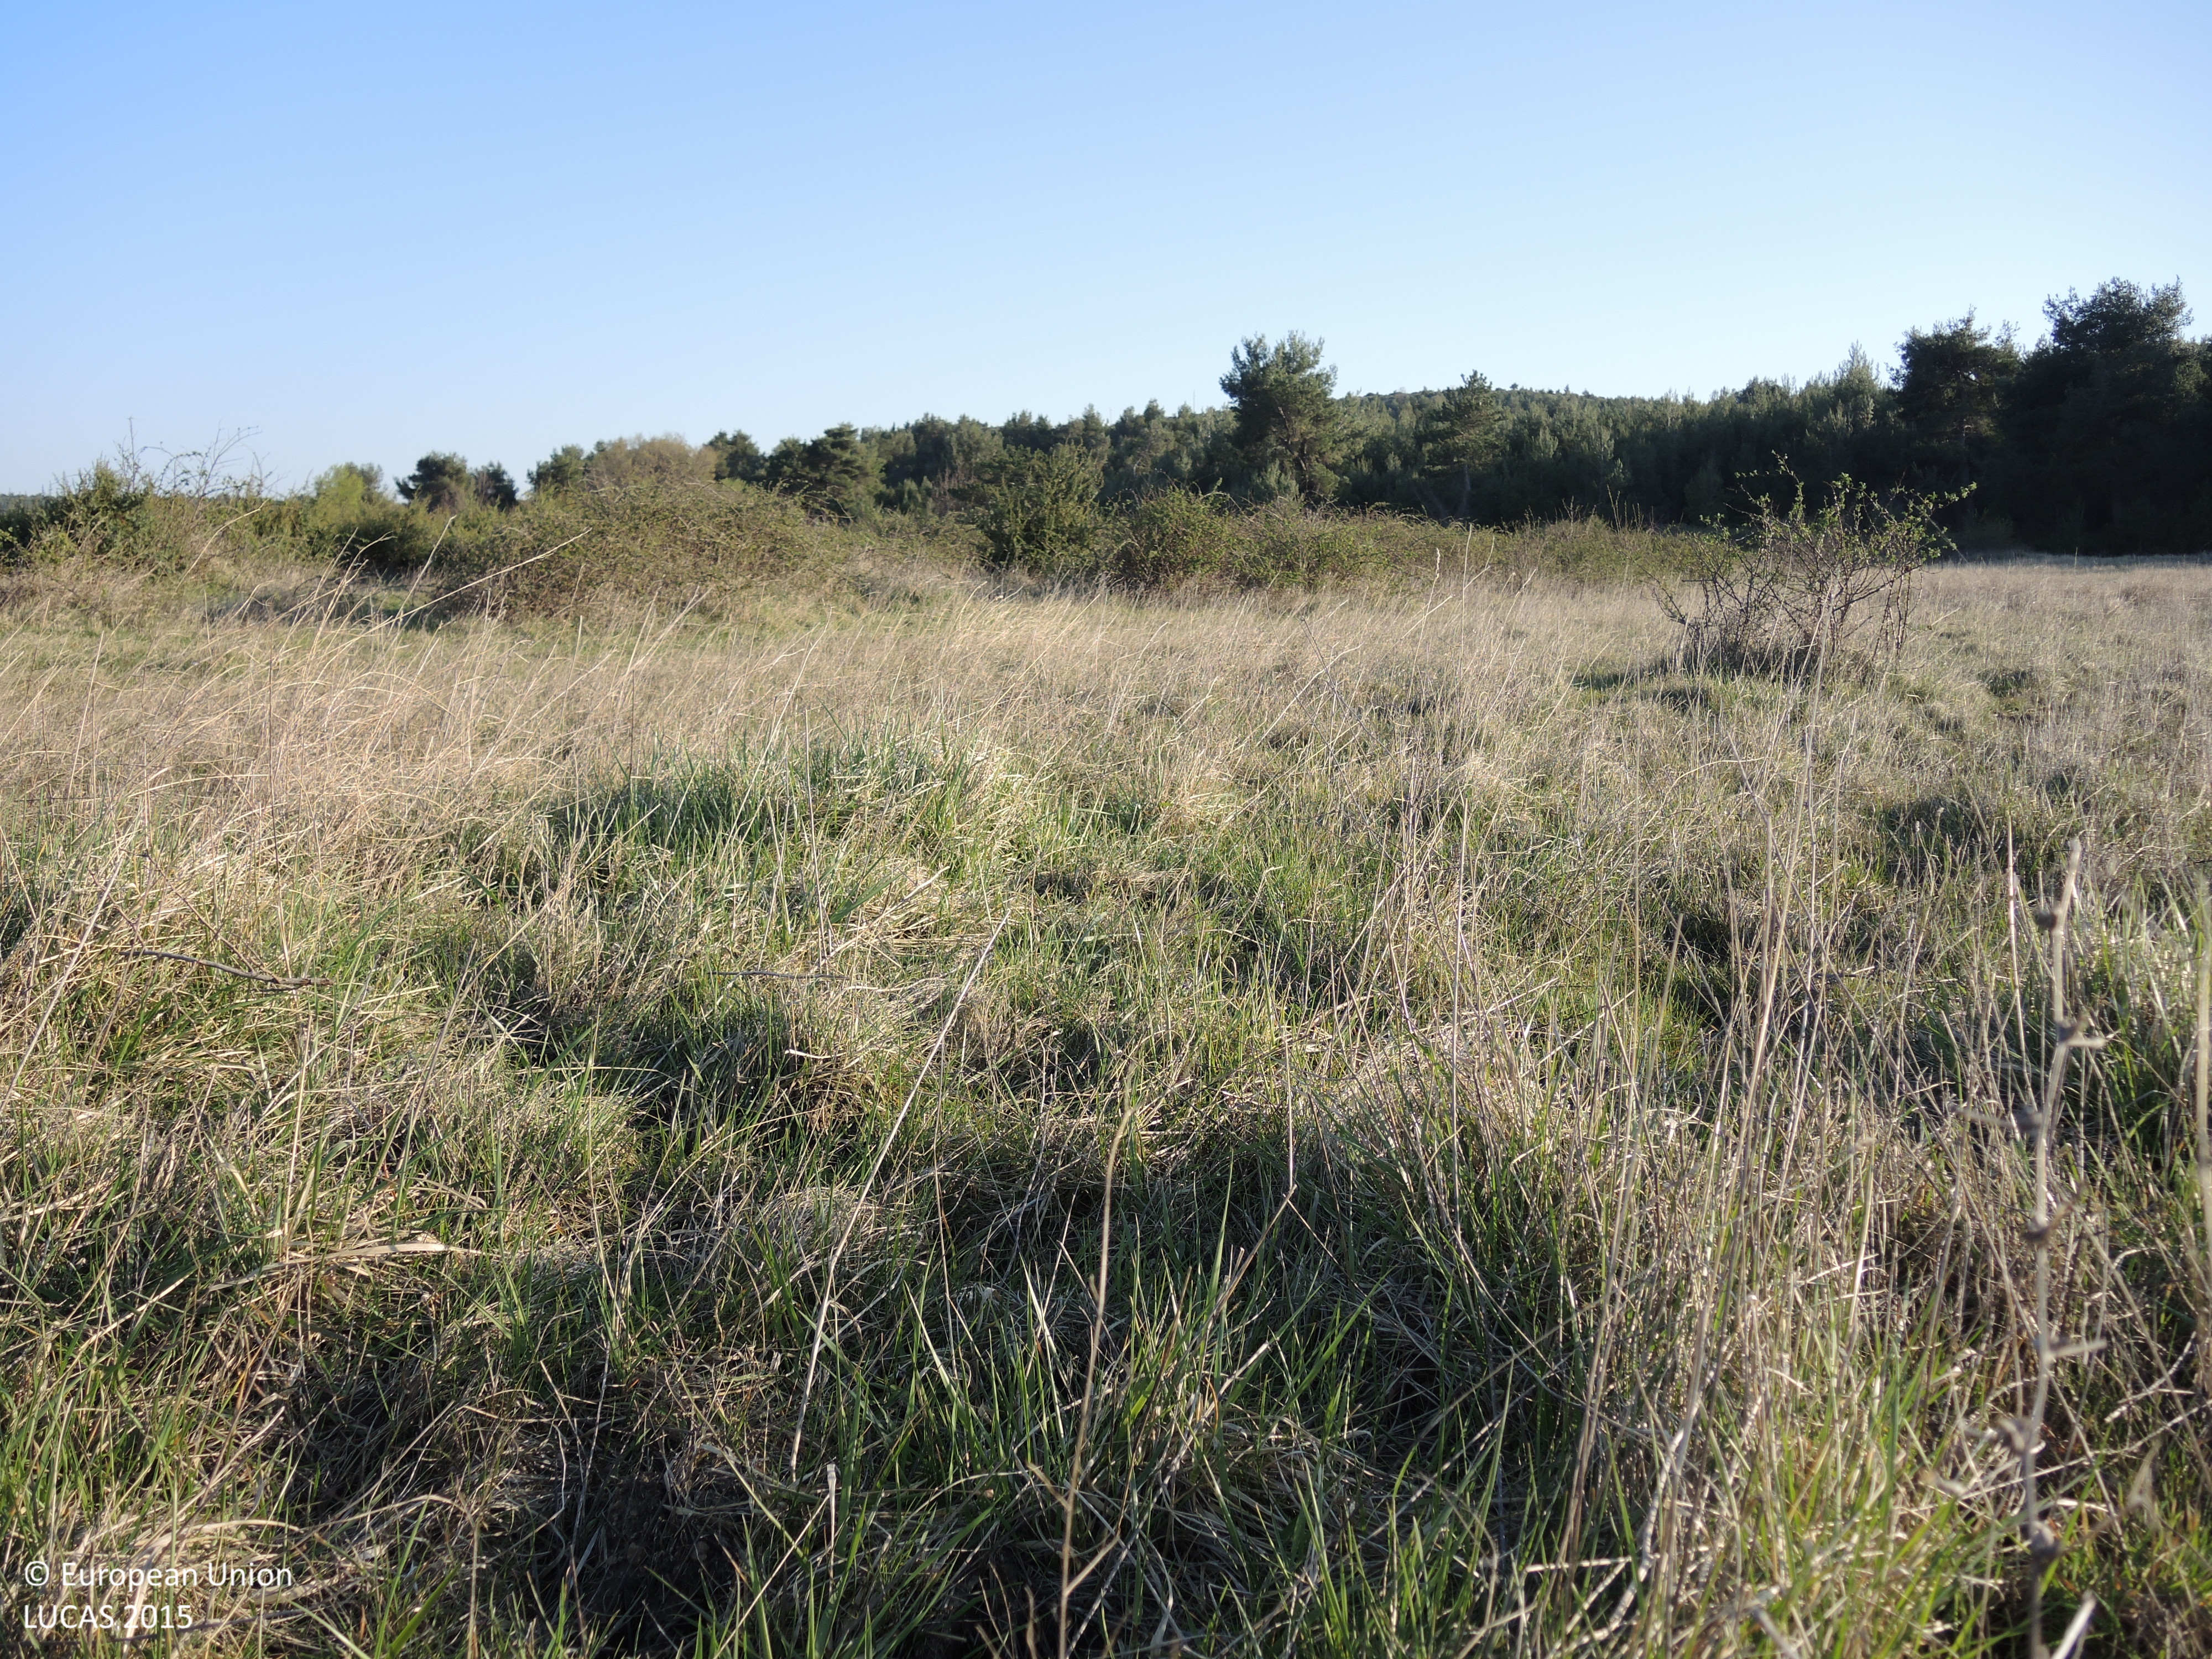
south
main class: Grassland
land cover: Grassland with sparse tree/shrub cover
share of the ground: > 75 %
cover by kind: herbaceous plants 80 %, shrubs 10 %, broadleaved forest trees 5 %, unconsolidated bare surface 5 %
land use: Abandoned areas
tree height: < 5 m
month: April
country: HR
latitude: 43.9347
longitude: 15.8092
